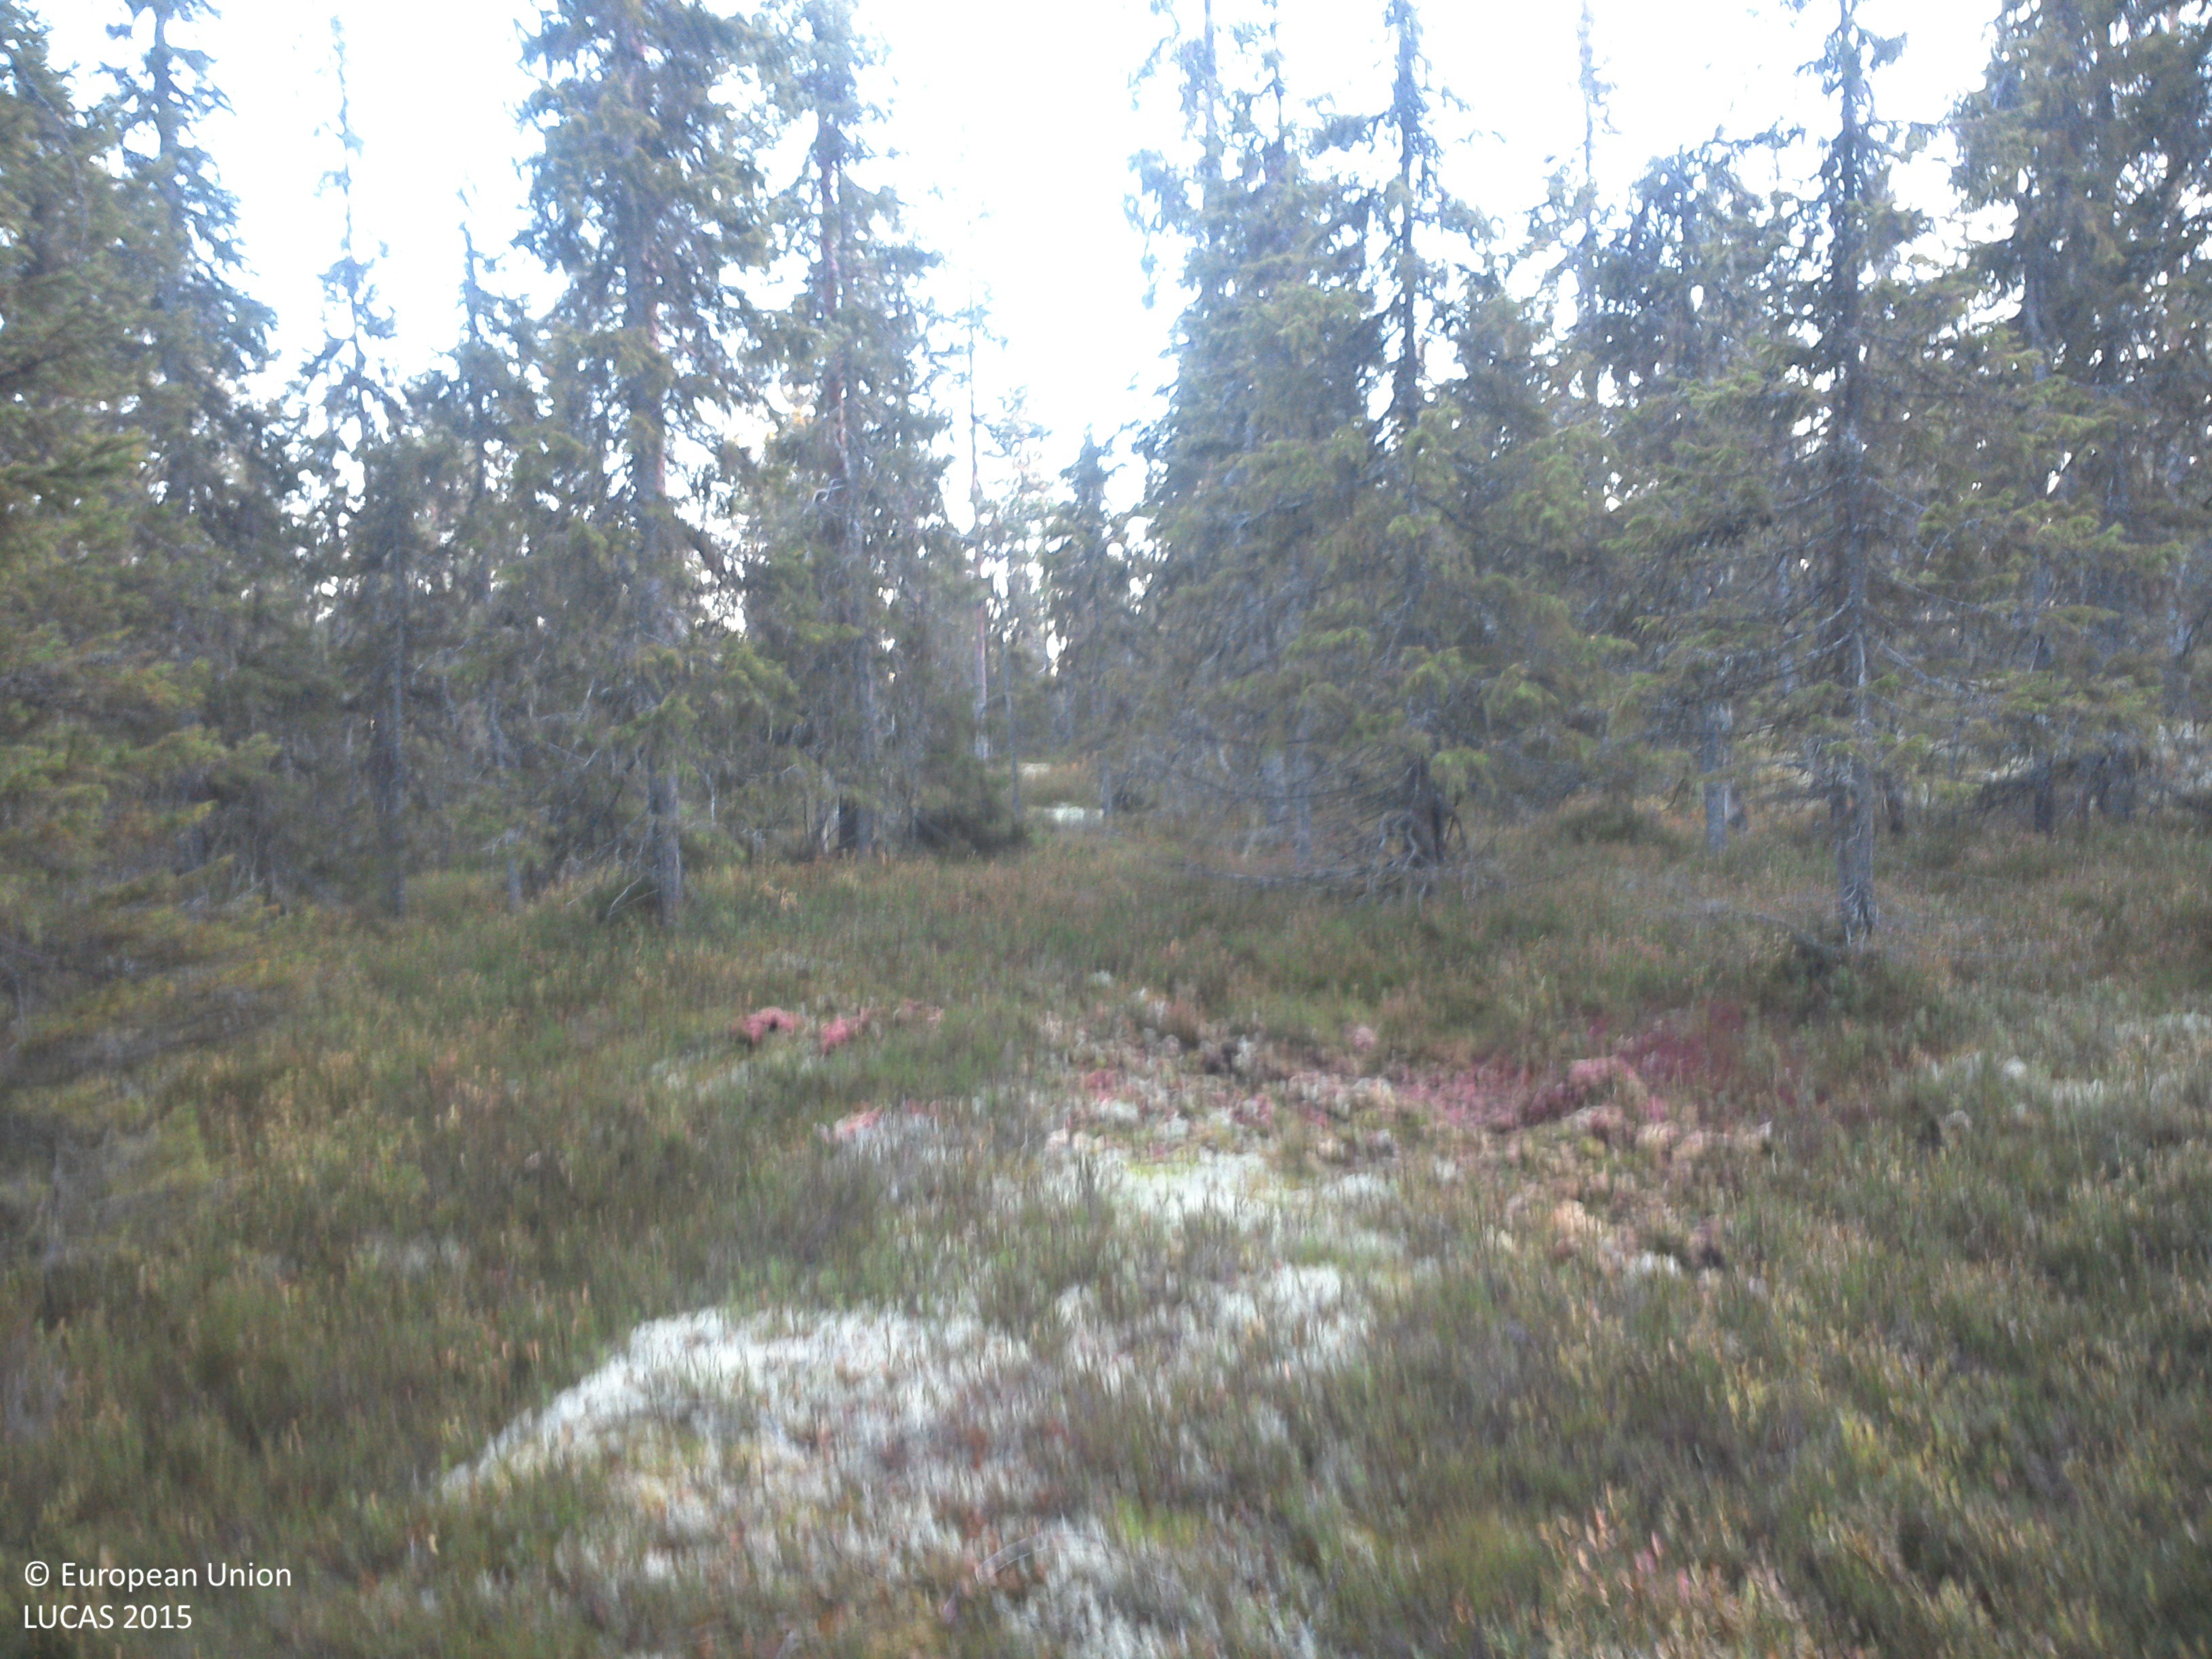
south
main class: Woodland
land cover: Spruce dominated coniferous woodland
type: boreal forest
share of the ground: 25 - 50 %
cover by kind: shrubs 60 %, coniferous forest trees 40 %
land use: Forestry
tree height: > 5 m
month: October
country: SE
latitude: 63.8268
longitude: 19.7118
